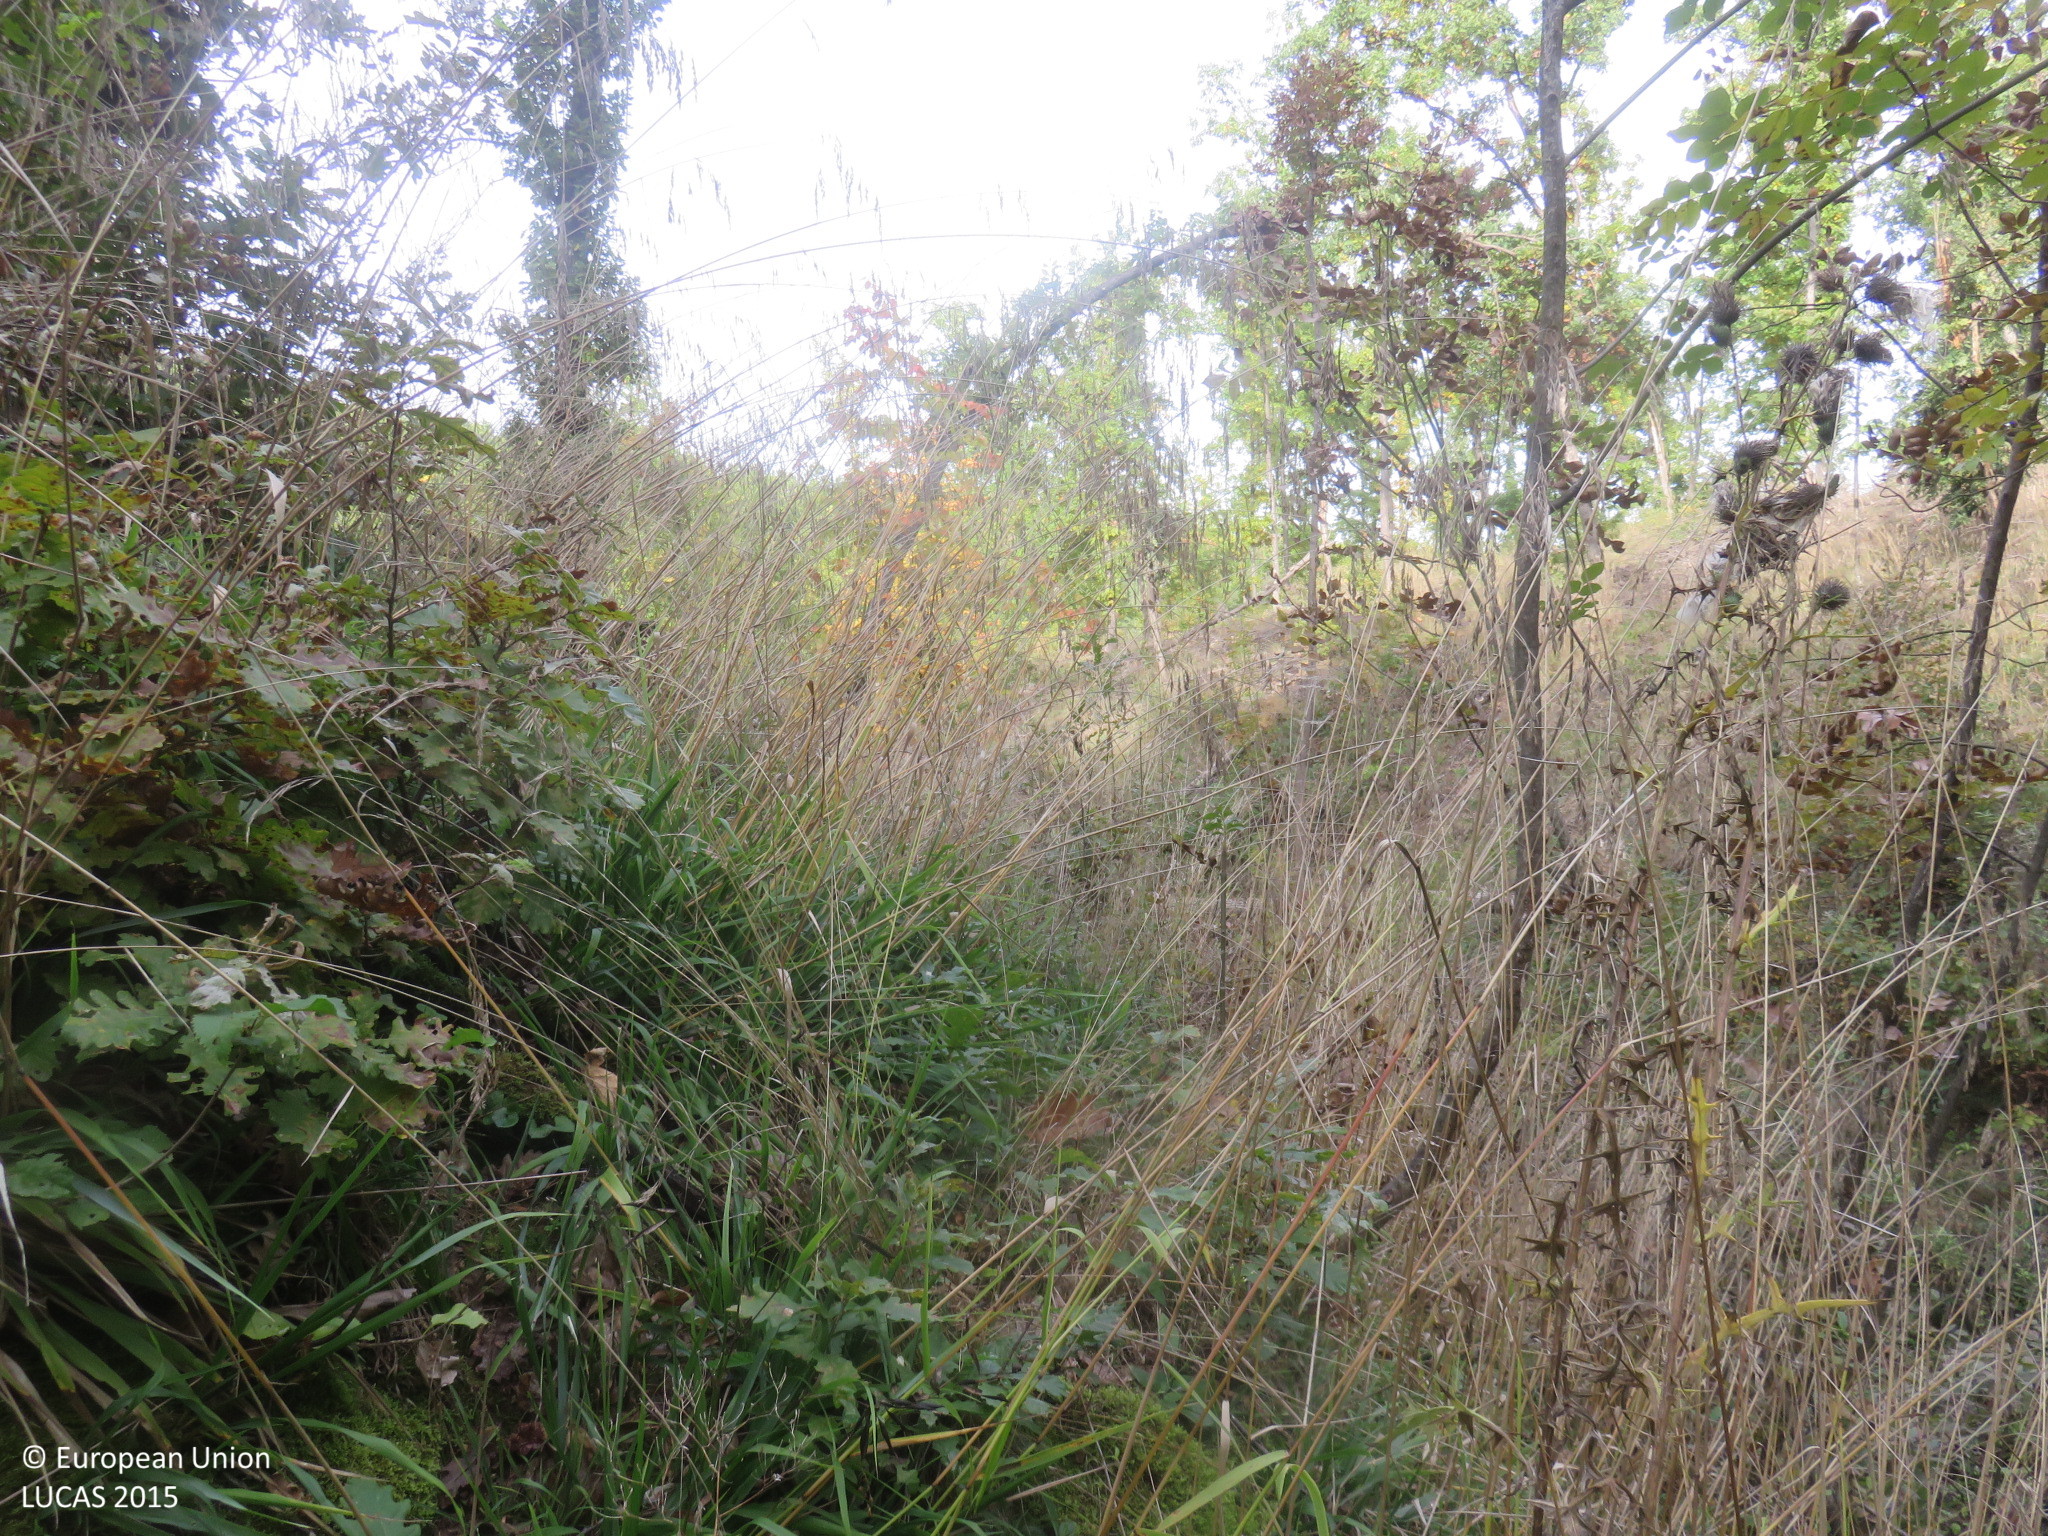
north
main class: Woodland
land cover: Broadleaved woodland
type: mesophytic deciduous forest
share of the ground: > 75 %
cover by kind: broadleaved forest trees 90 %, herbaceous plants 5 %, unconsolidated bare surface 5 %
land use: Forestry
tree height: < 5 m
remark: Clear cut
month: October
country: BG
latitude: 42.9231
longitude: 24.9995
